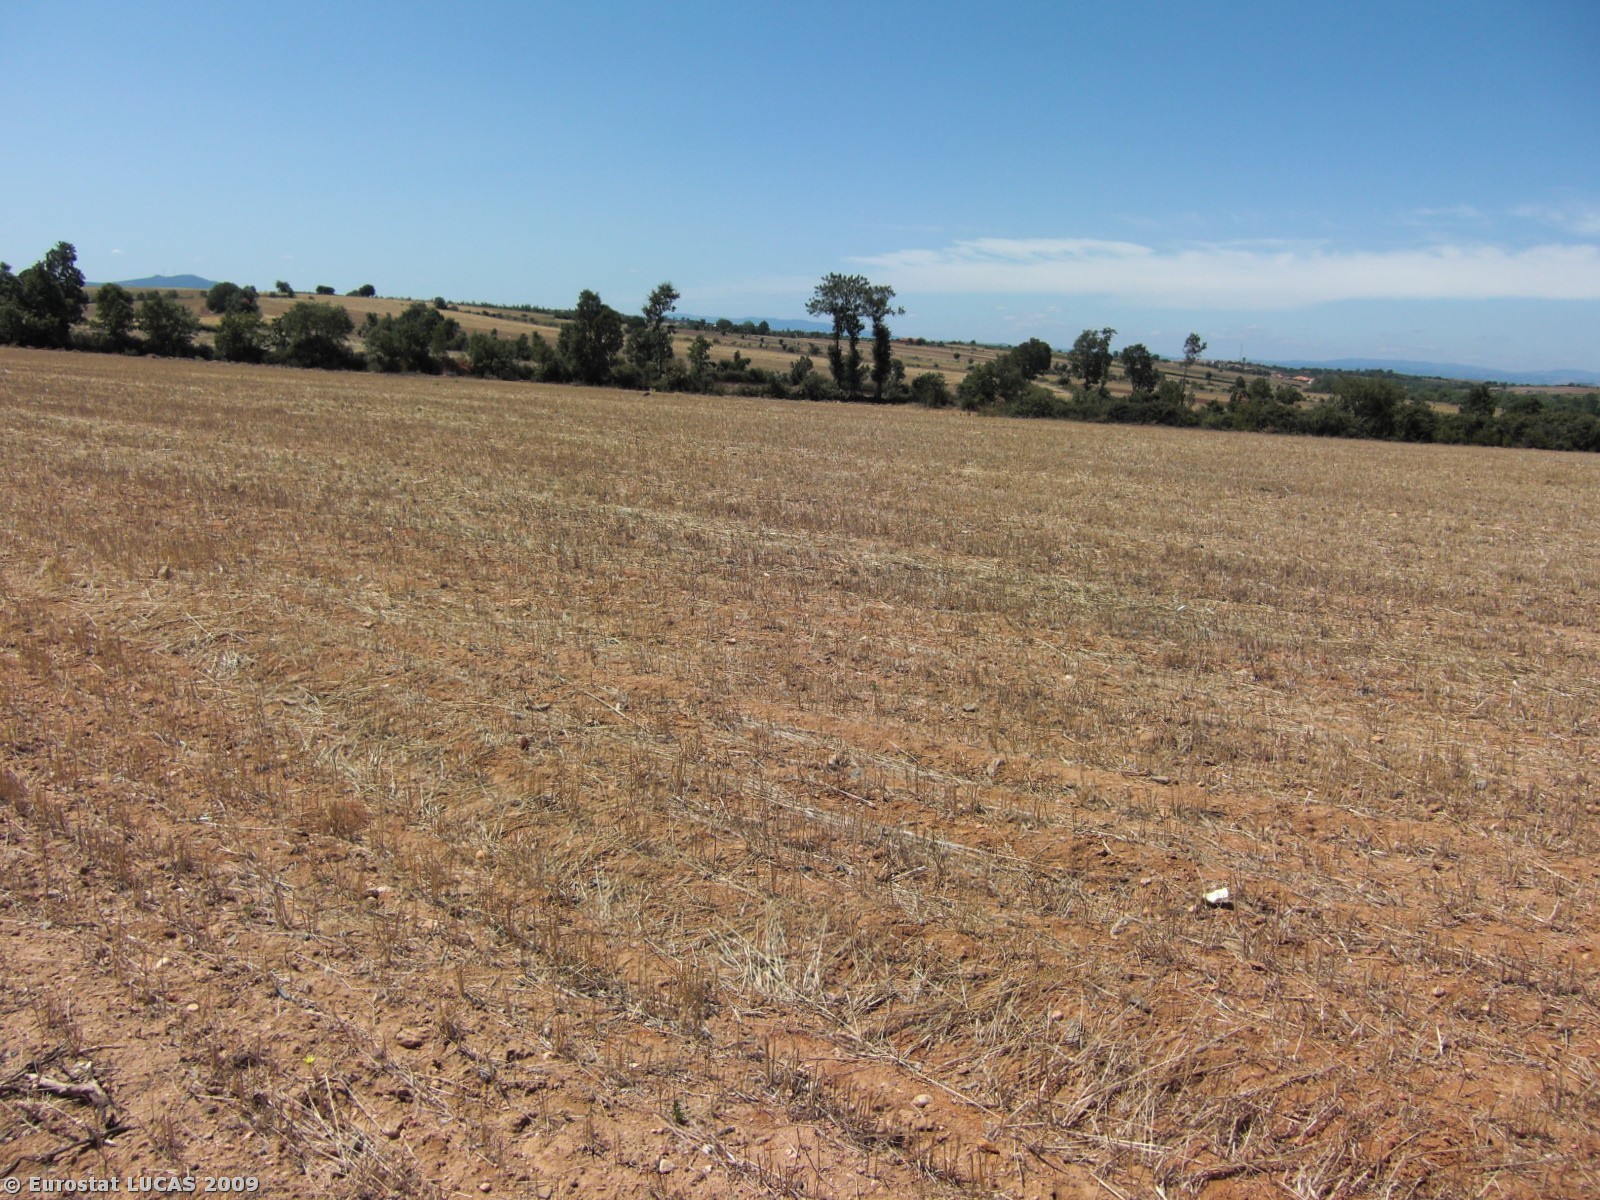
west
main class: Grassland
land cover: Spontaneously vegetated surfaces
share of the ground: > 75 %
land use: Fallow land
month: August
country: PT
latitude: 41.4511
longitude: -6.4158
